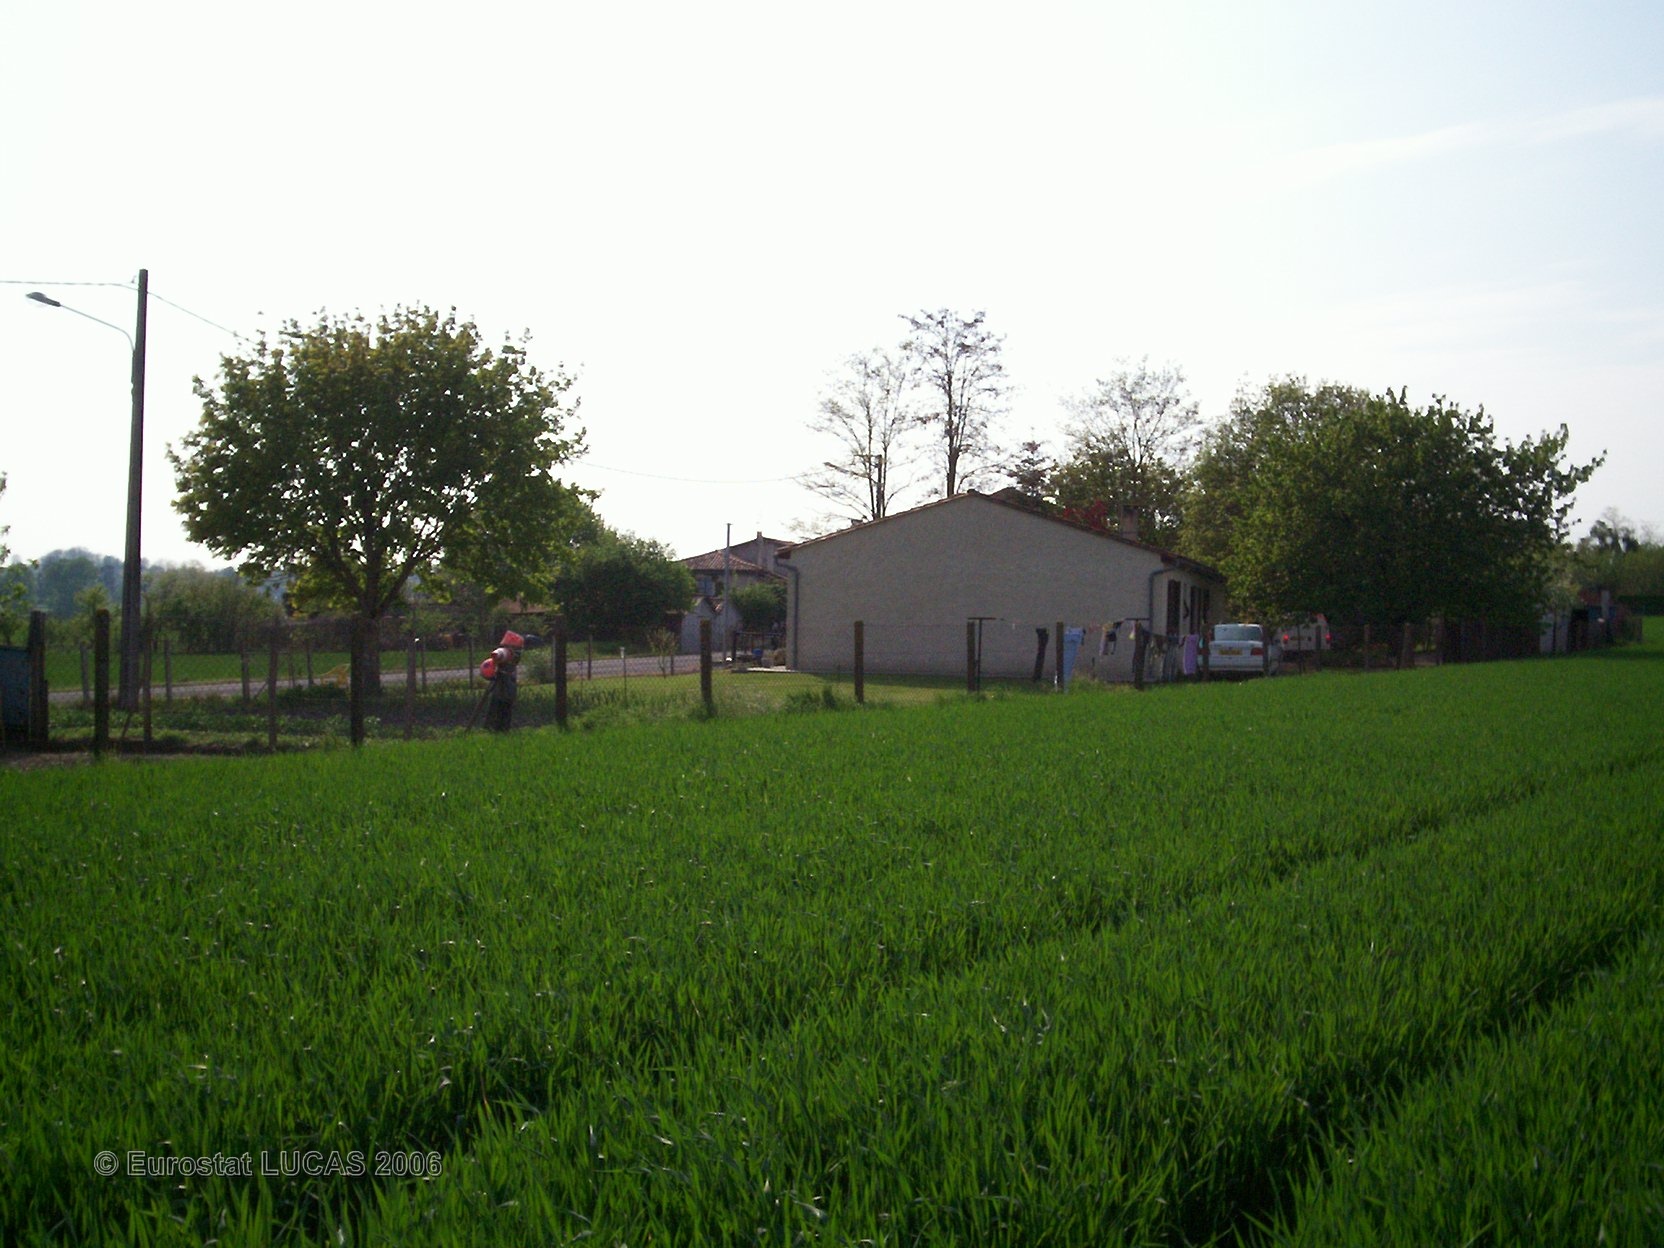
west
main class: Cropland
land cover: Common wheat
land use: Agriculture (excluding fallow land and kitchen gardens)
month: April
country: FR
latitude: 45.4693
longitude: -0.1355
